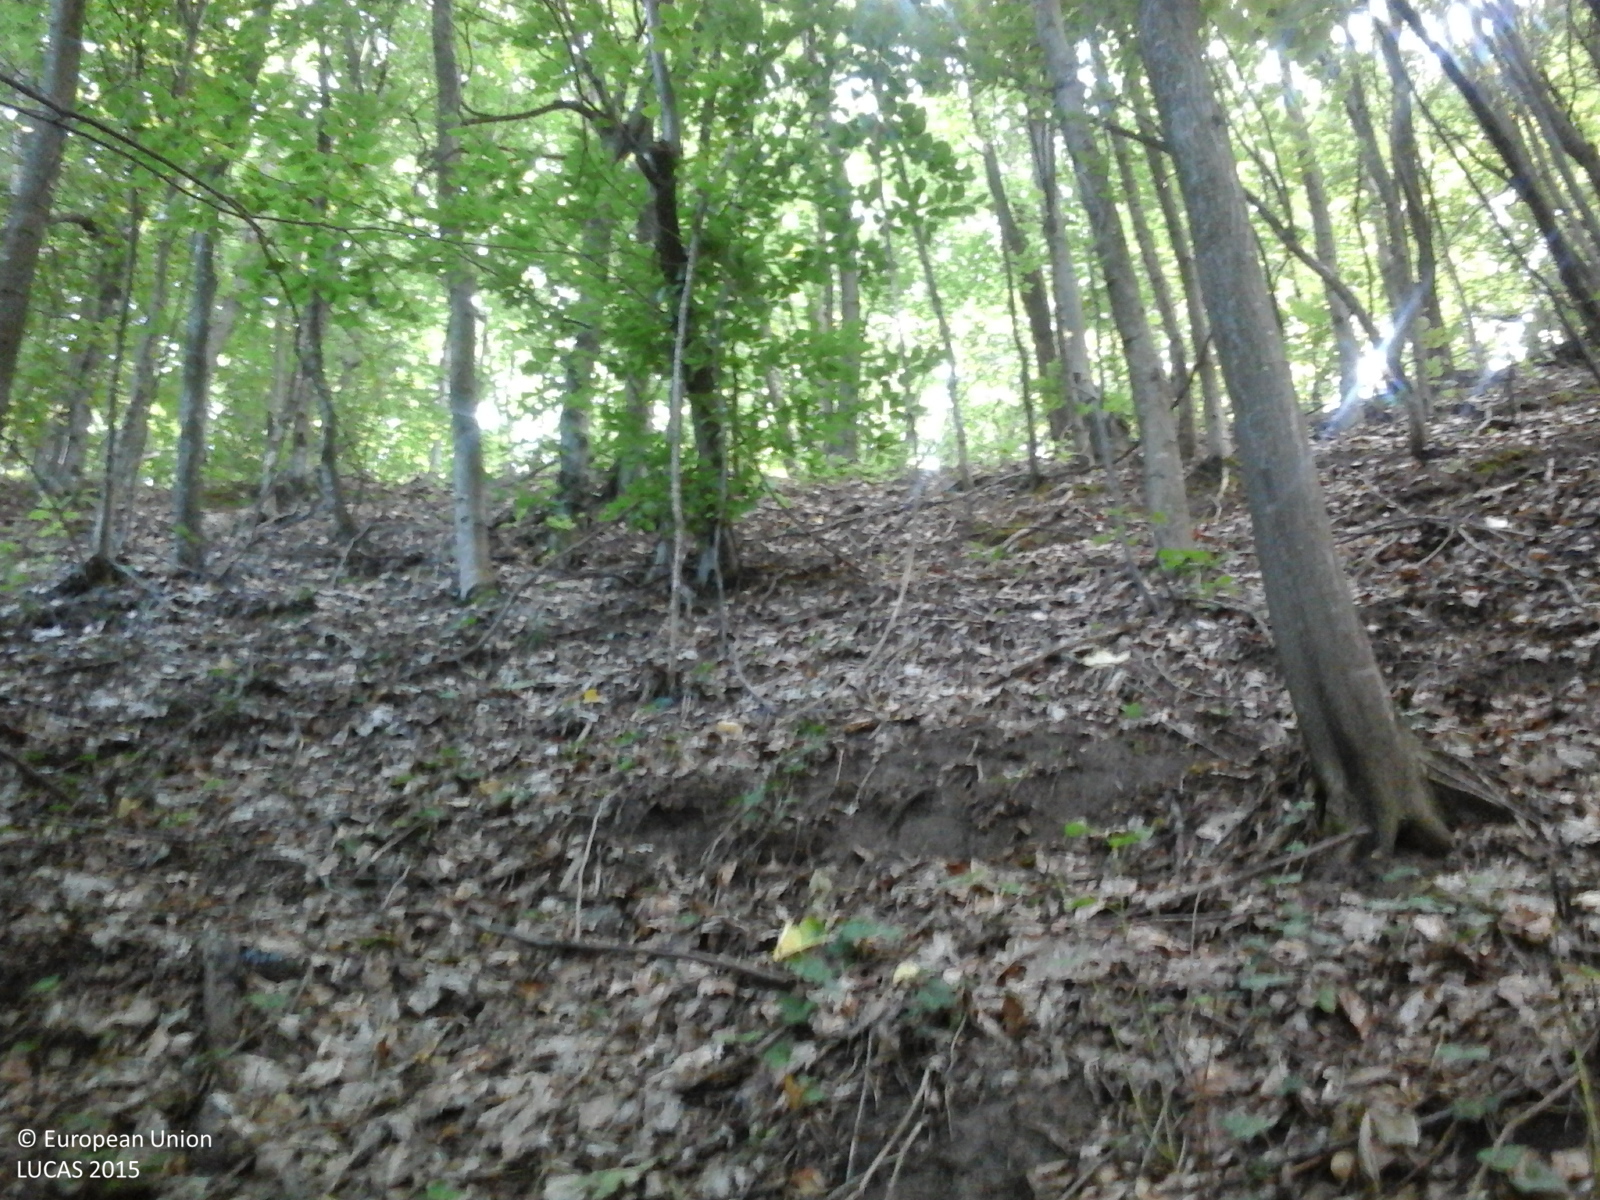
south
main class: Woodland
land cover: Broadleaved woodland
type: beech forest
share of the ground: > 75 %
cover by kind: broadleaved forest trees 100 %
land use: Forestry
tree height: > 5 m
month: June
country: RO
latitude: 46.7722
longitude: 27.2745
